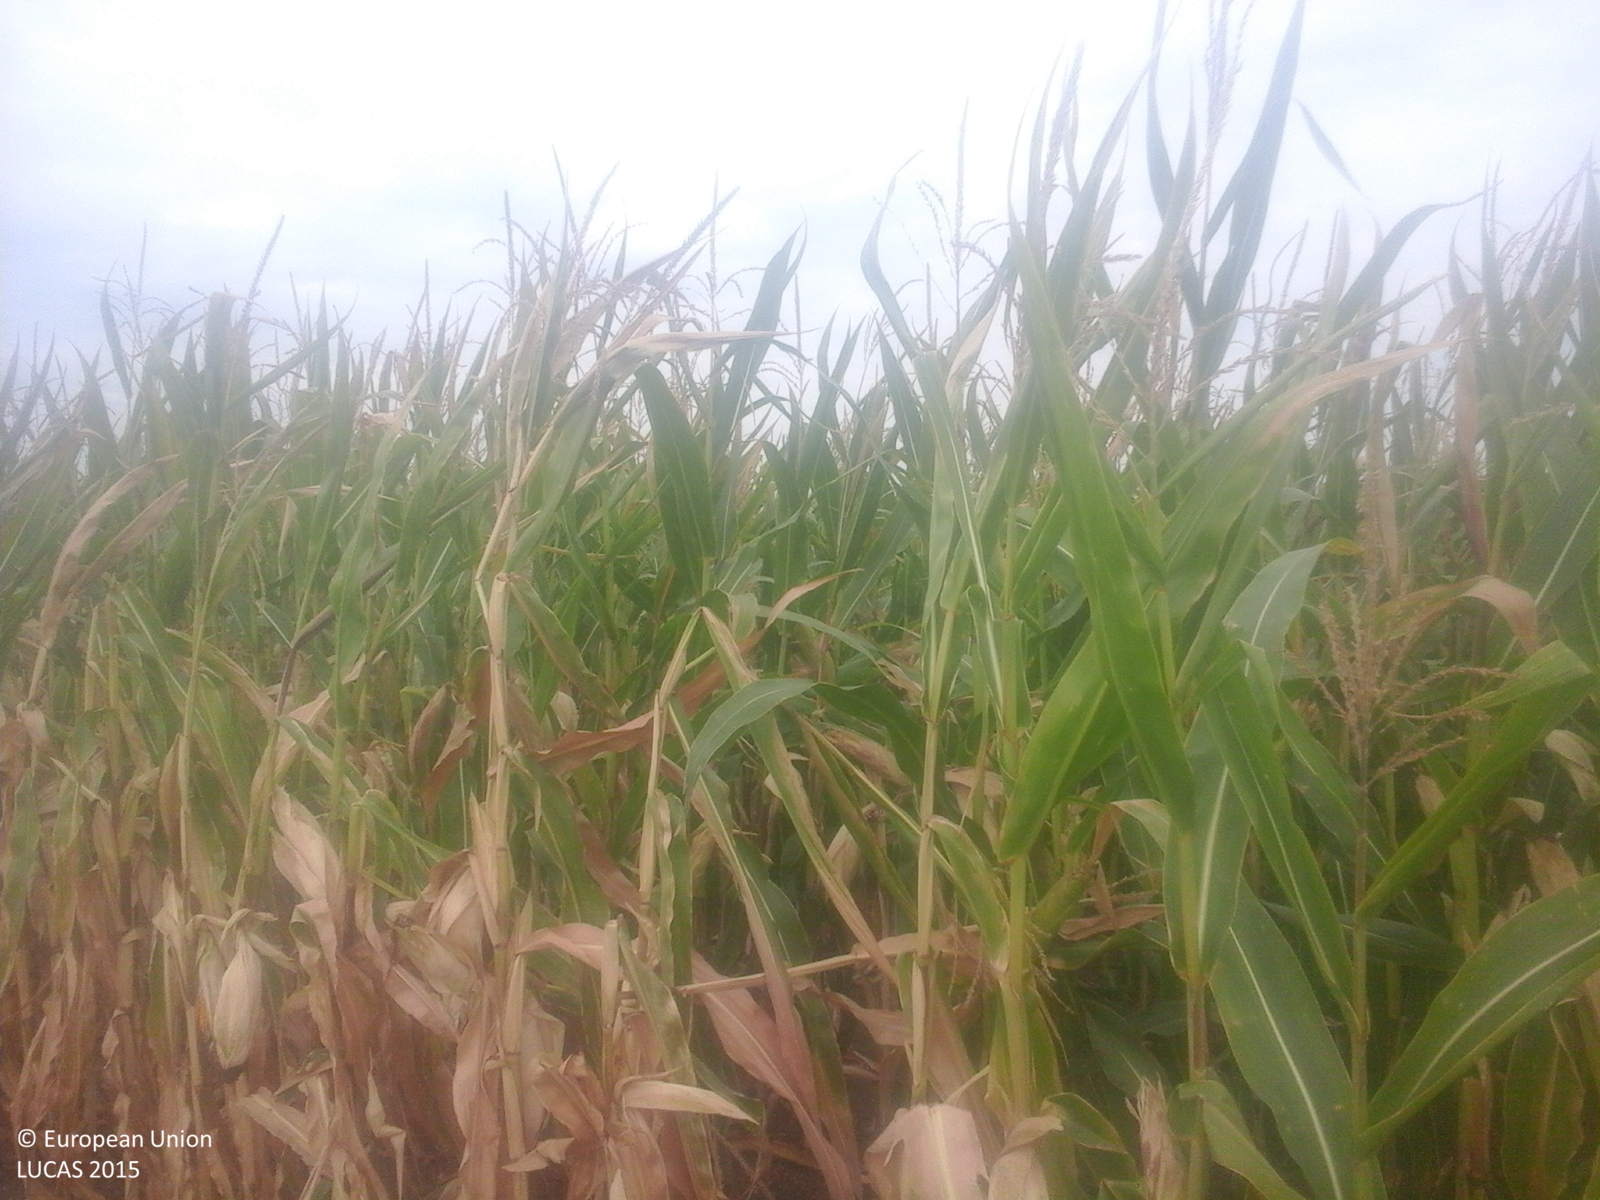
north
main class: Cropland
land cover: Maize
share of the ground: > 75 %
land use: Agriculture (excluding fallow land and kitchen gardens)
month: September
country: RO
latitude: 47.7685
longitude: 22.6162
